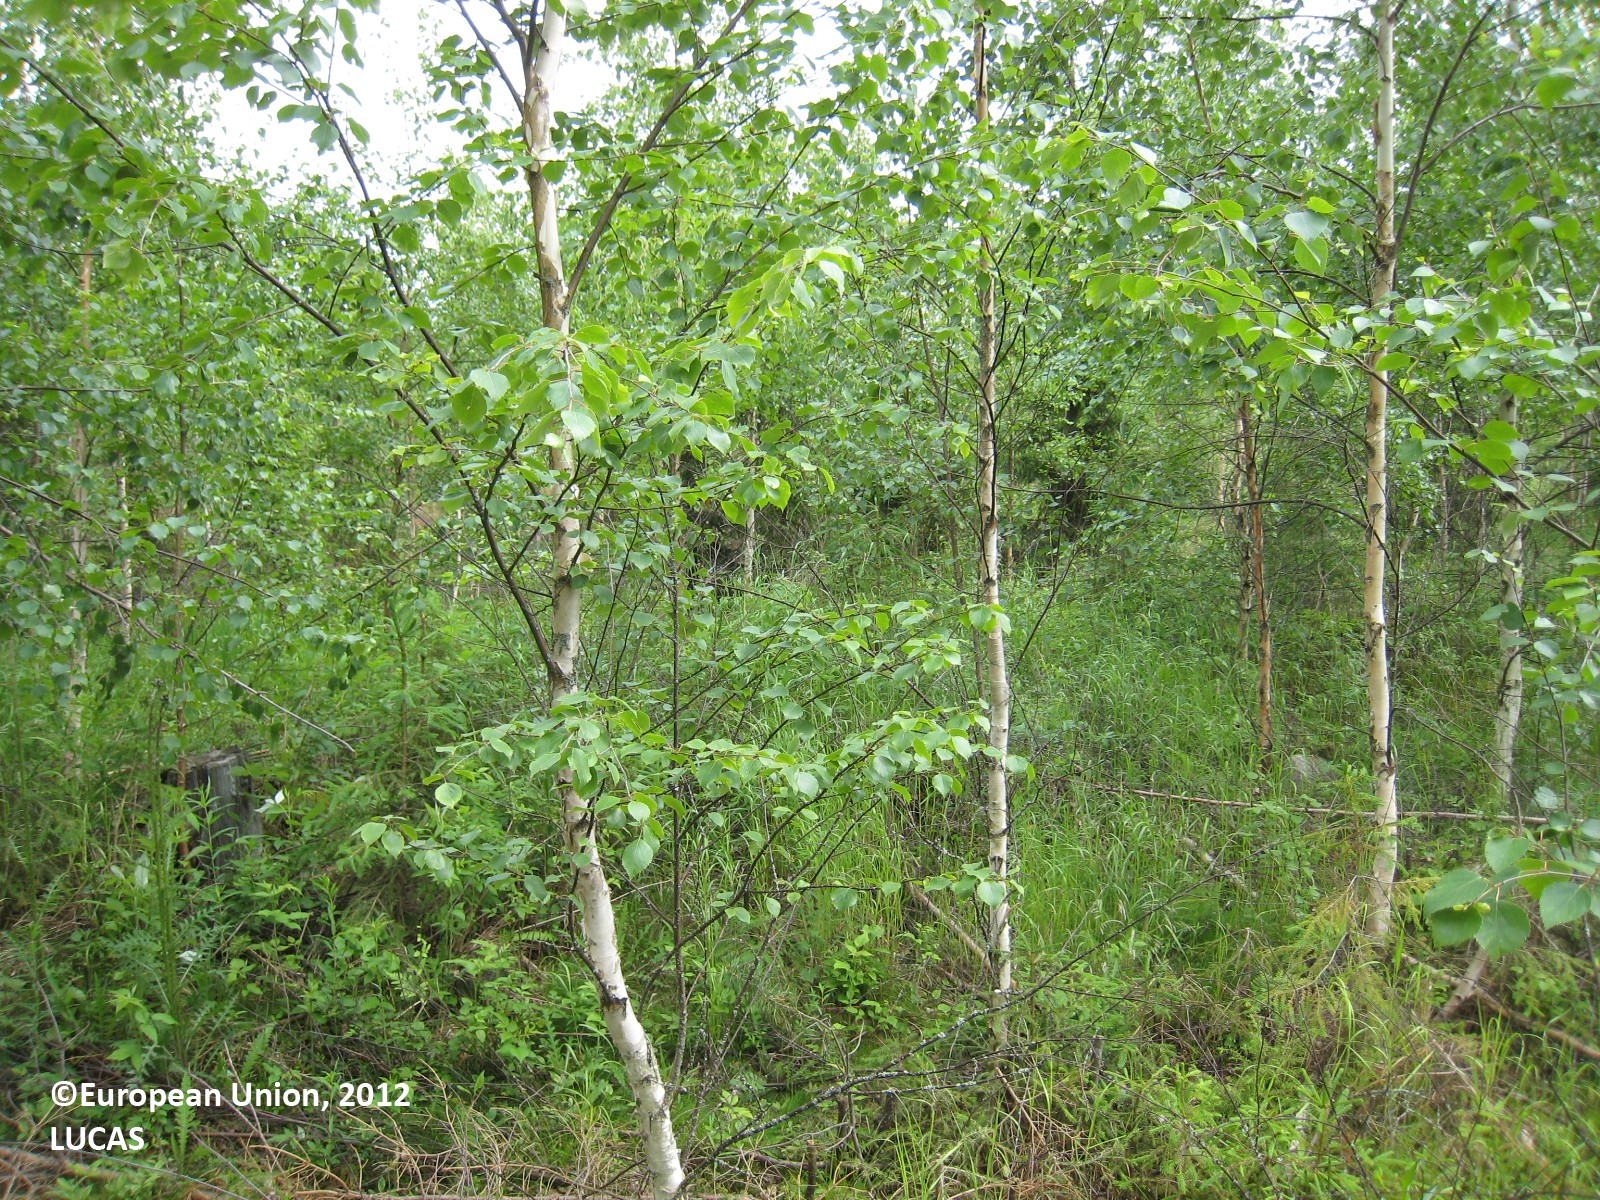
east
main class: Woodland
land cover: Broadleaved woodland
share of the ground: 50 - 75 %
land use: Forestry
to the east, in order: Broadleaved woodland; Ditches and canals; Spruce dominated mixed woodland; Ditches and canals; Spruce dominated mixed woodland; Pine dominated coniferous woodland; Other coniferous woodland; Shrubland with sparse tree cover; Other bare soil; Shrubland with sparse tree cover; Ditches and canals; Spruce dominated coniferous woodland; Other mixed woodland; Ditches and canals; Pine dominated mixed woodland
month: June
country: FI
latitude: 62.2223
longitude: 26.3901
